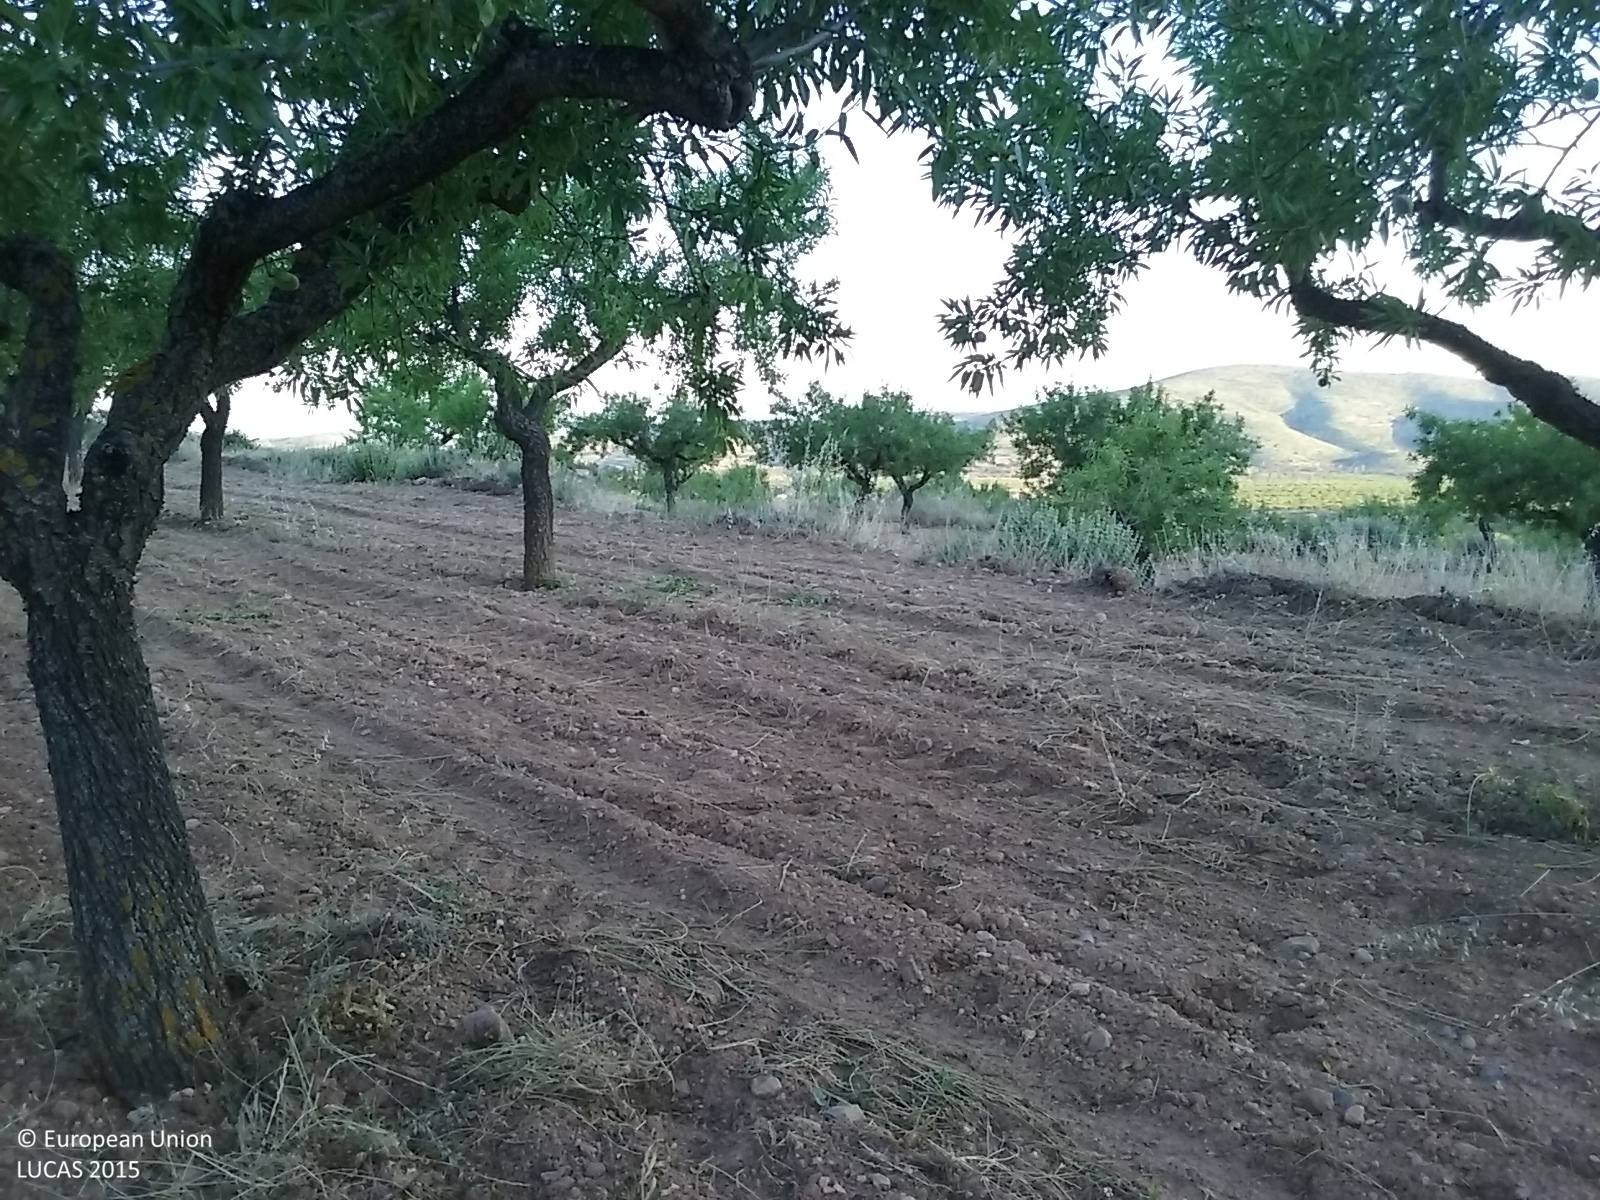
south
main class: Cropland
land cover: Nuts trees
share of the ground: 50 - 75 %
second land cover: Other bare soil
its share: > 75 %
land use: Agriculture (excluding fallow land and kitchen gardens)
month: June
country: ES
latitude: 39.8066
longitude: -0.7134
